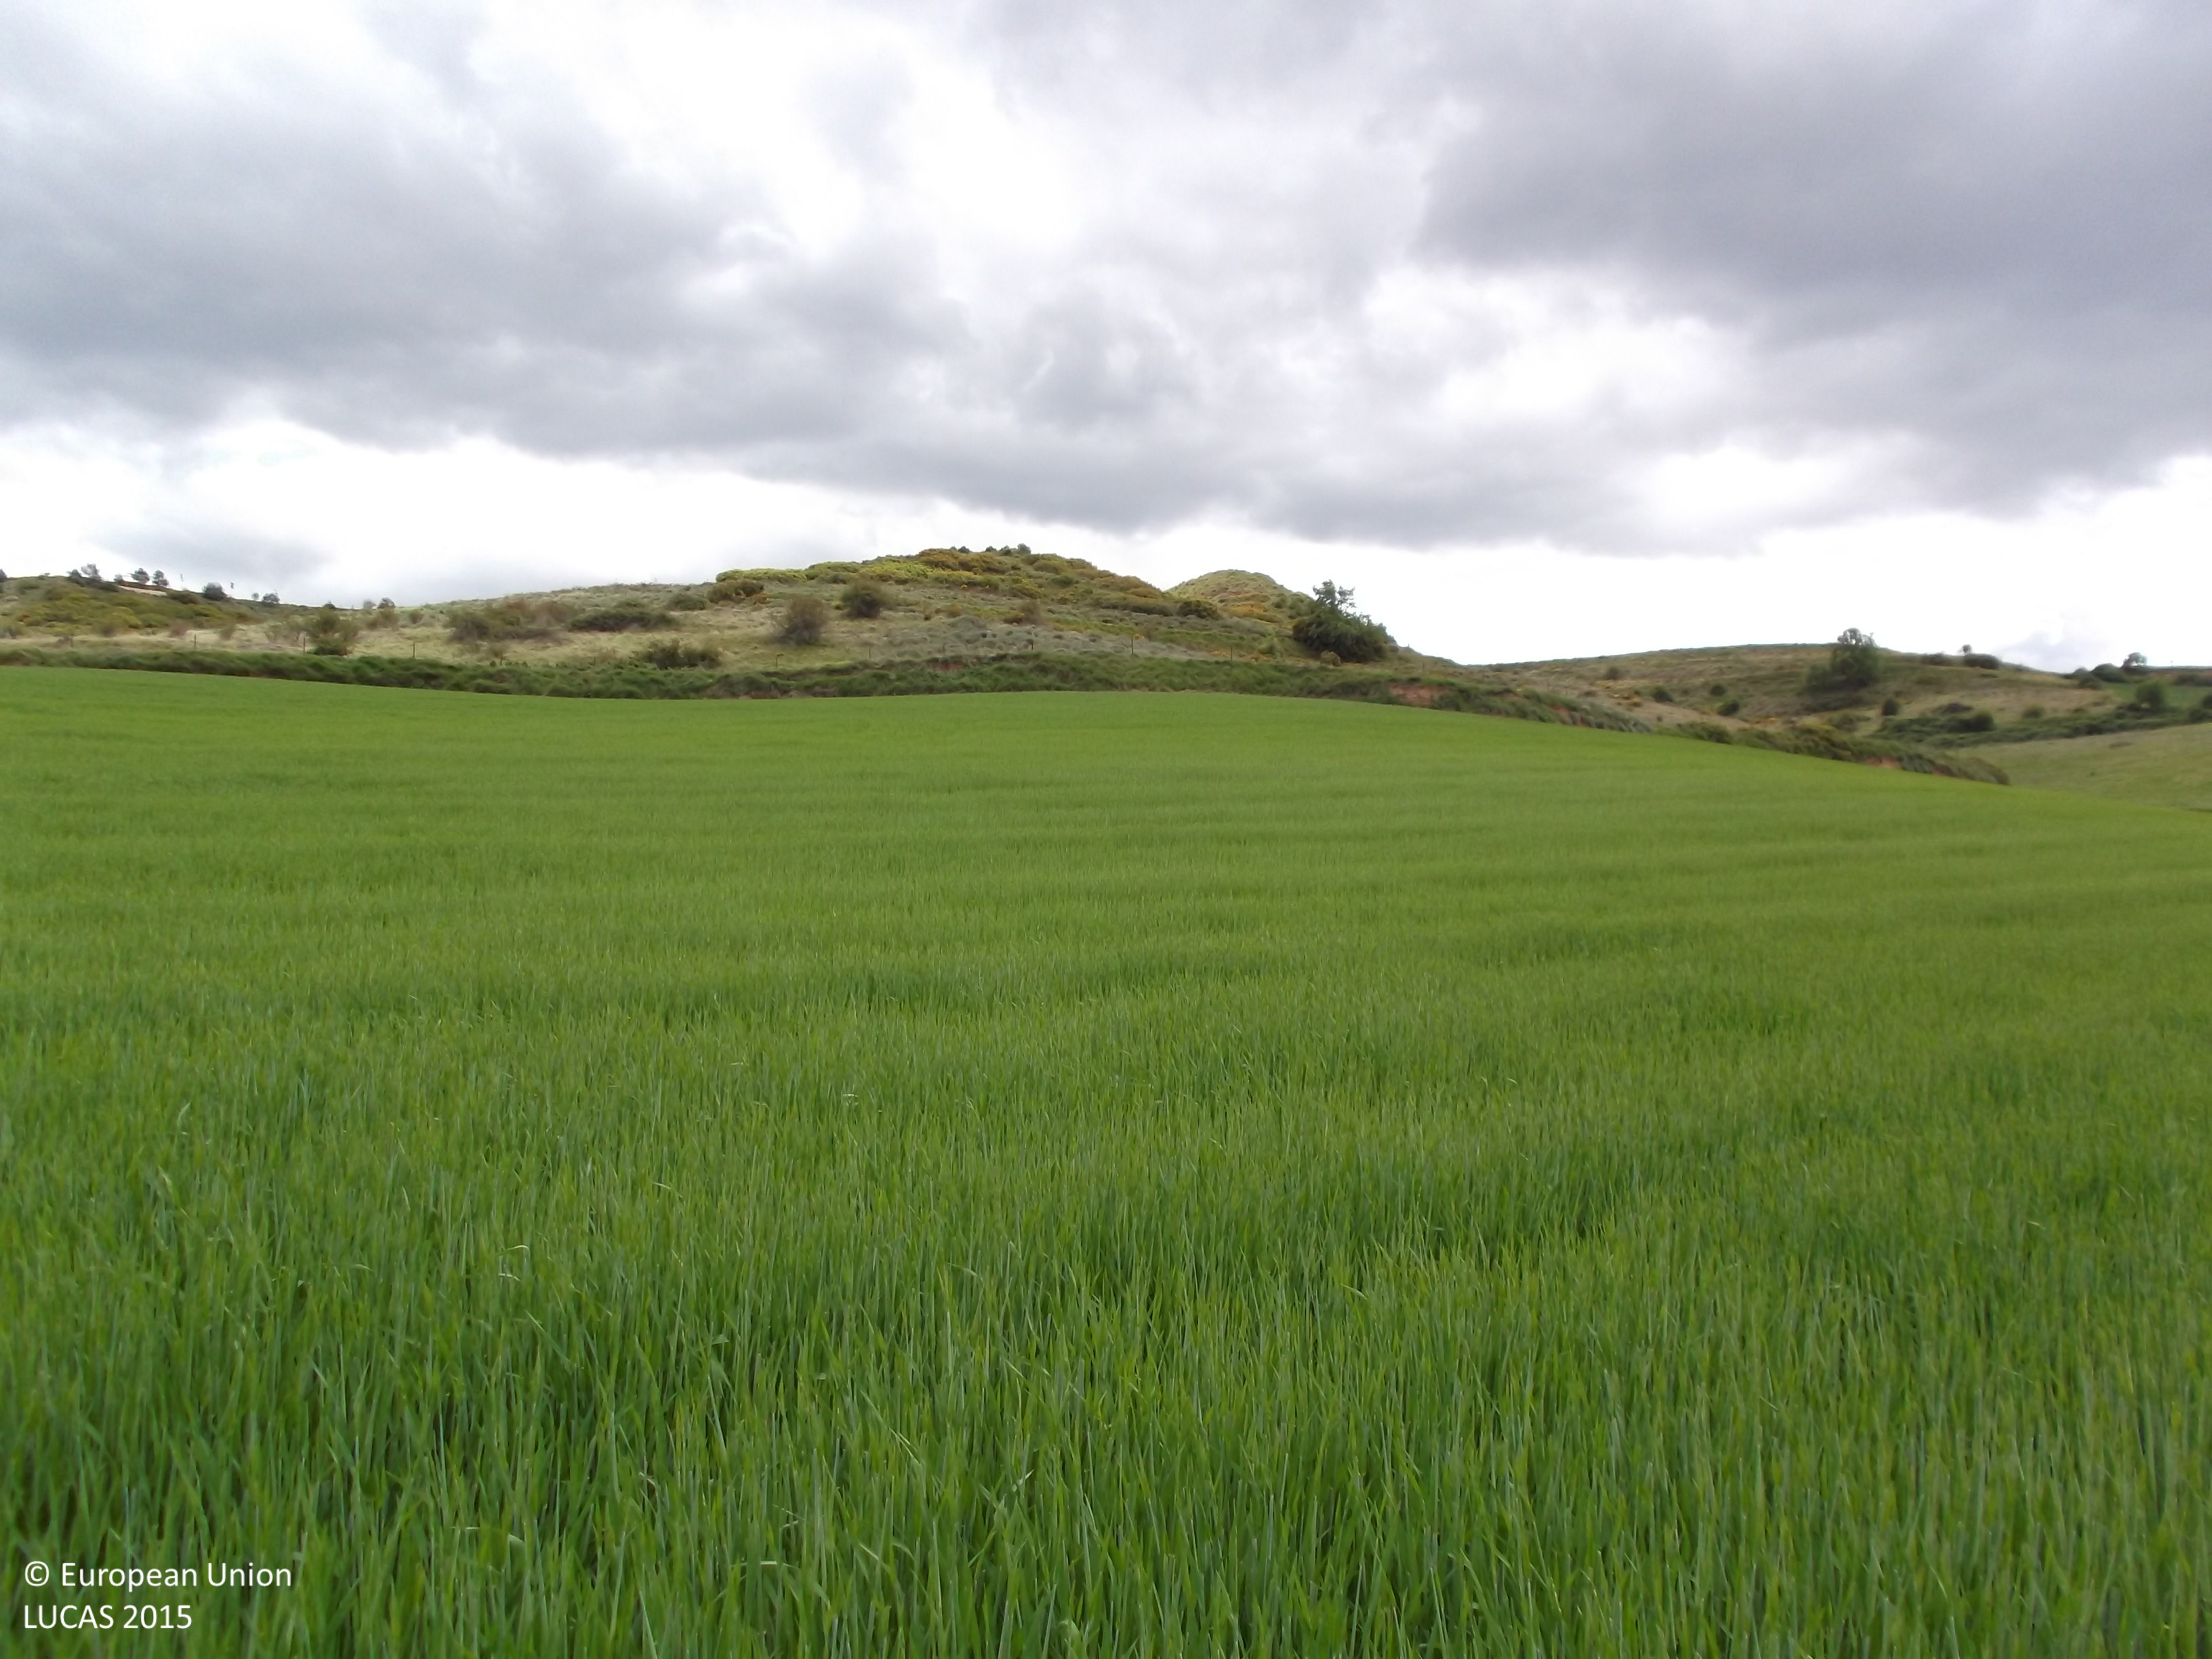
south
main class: Cropland
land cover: Barley
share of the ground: > 75 %
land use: Agriculture (excluding fallow land and kitchen gardens)
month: May
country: ES
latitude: 42.3792
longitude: -2.4196
